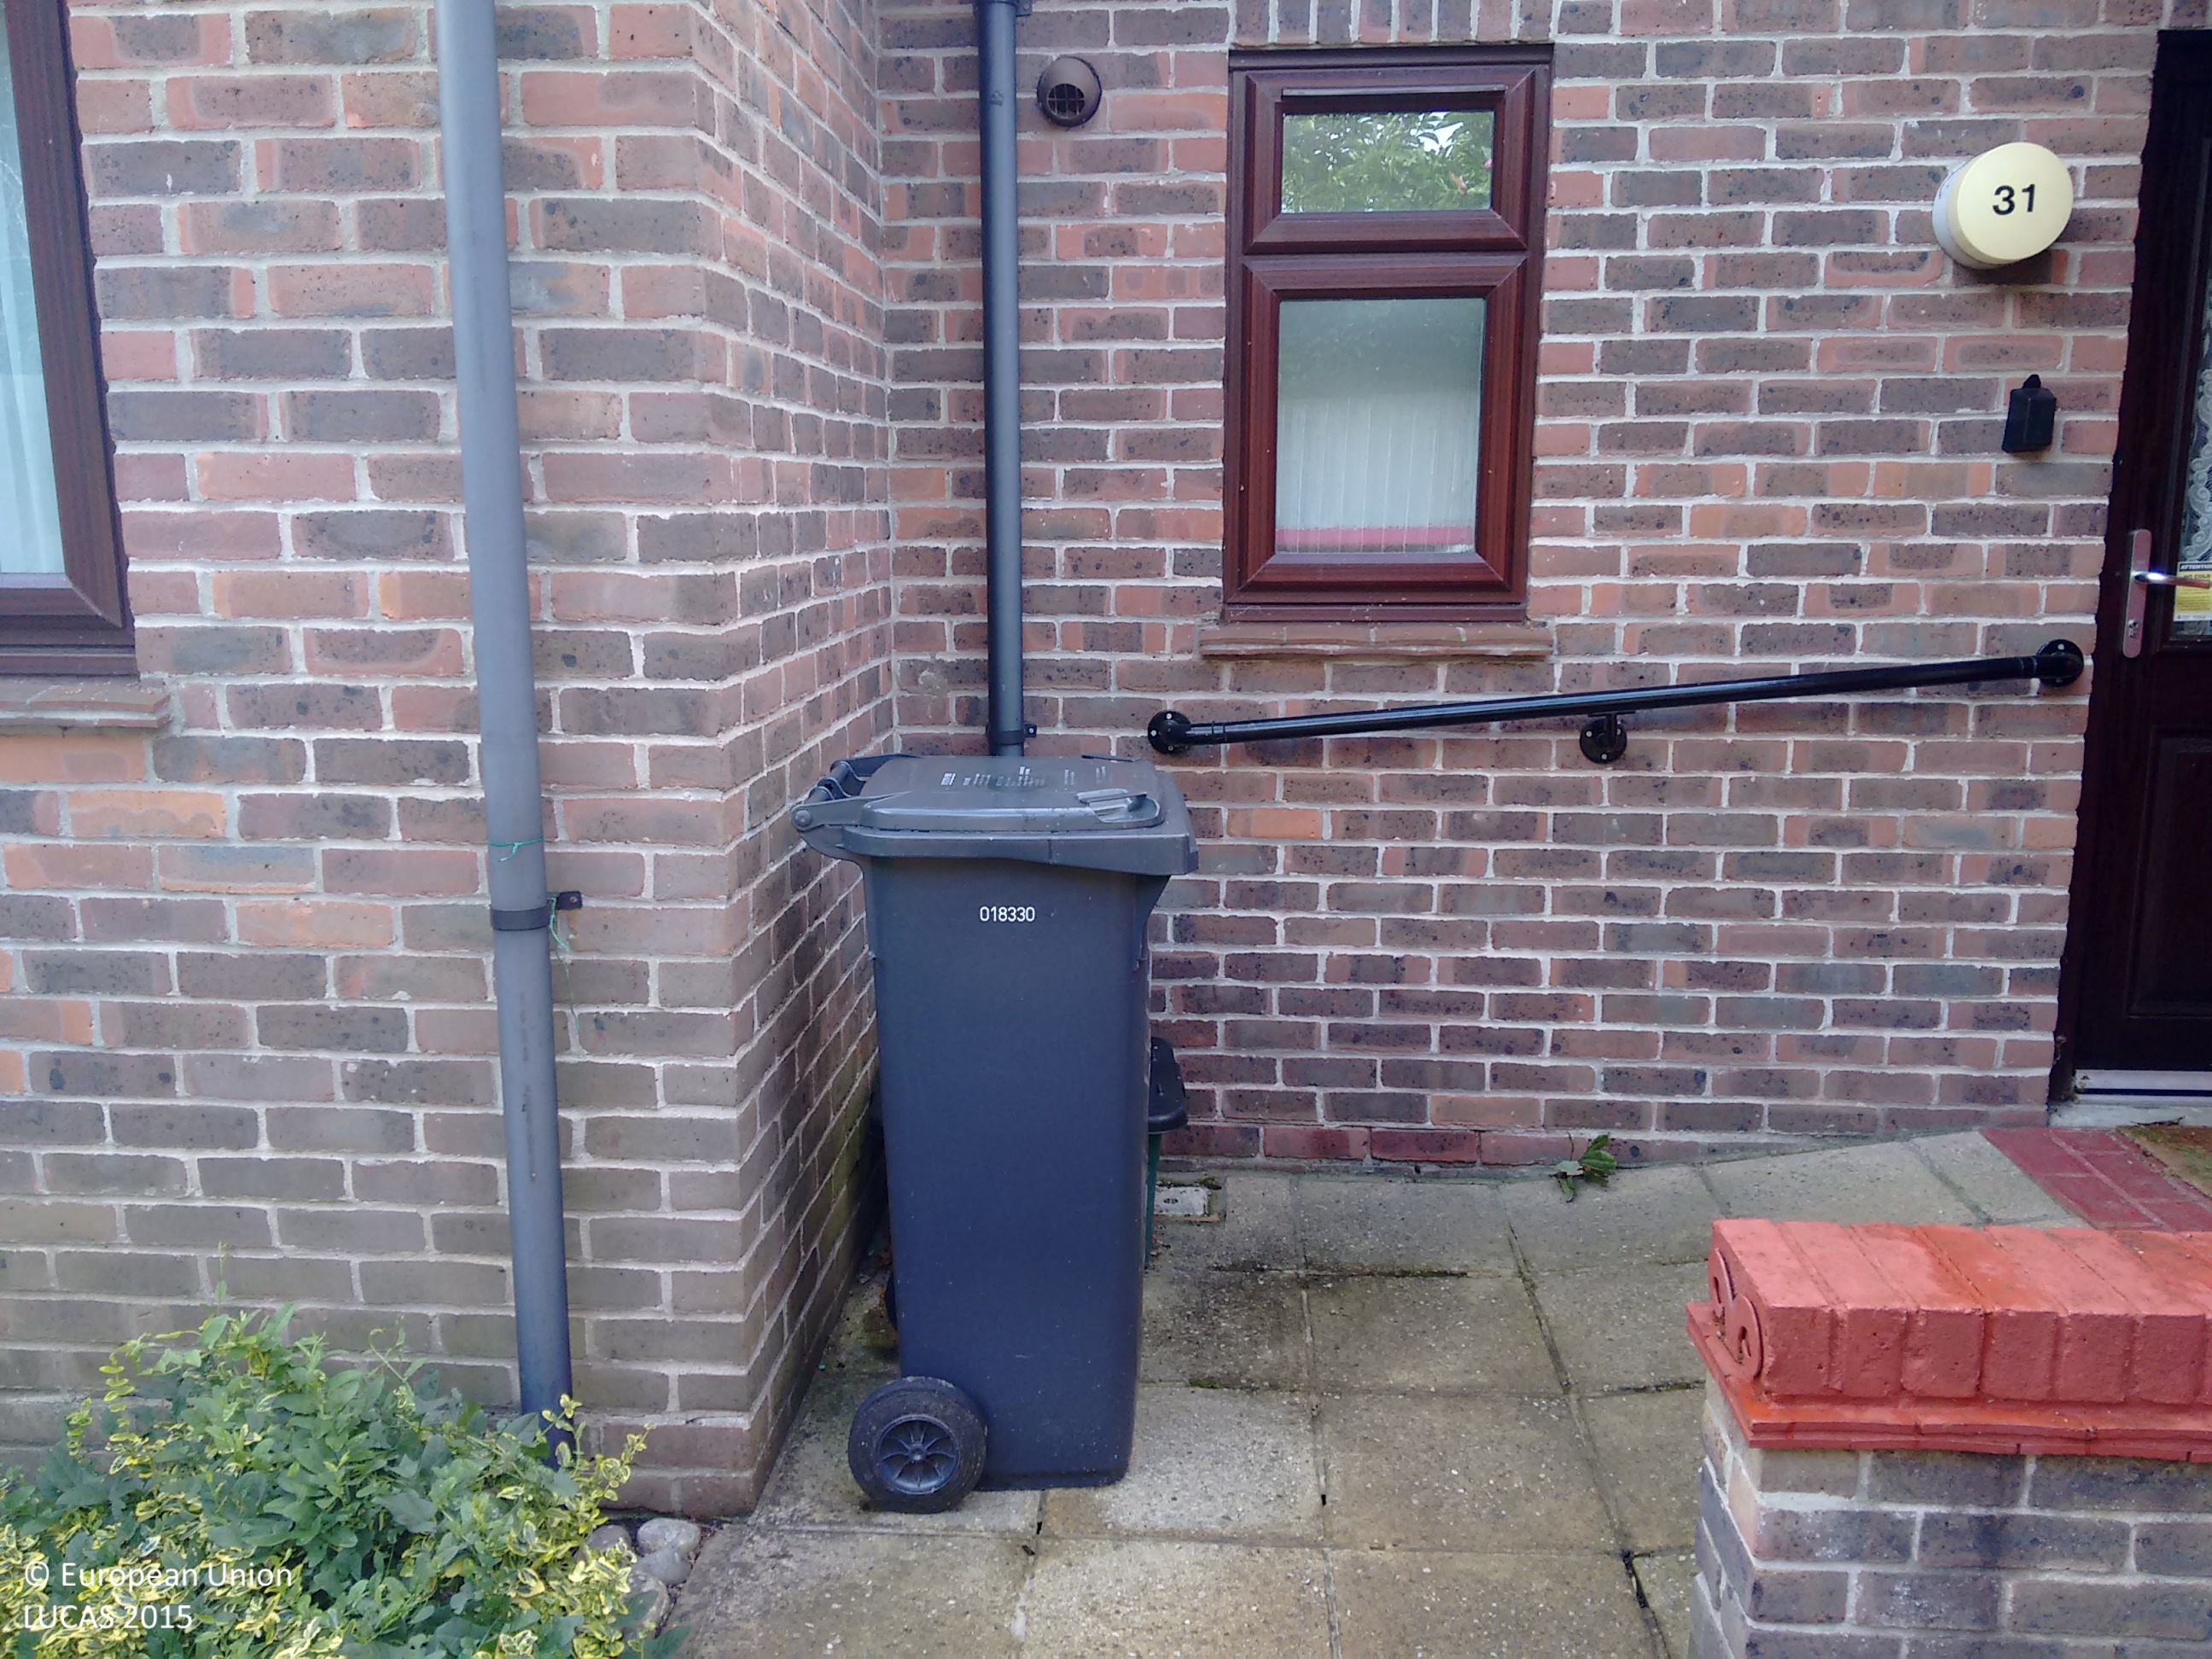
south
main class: Grassland
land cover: Grassland with sparse tree/shrub cover
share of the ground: > 75 %
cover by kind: herbaceous plants 95 %, broadleaved forest trees 5 %
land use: Residential
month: September
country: GB
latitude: 52.6324
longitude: 1.2469
